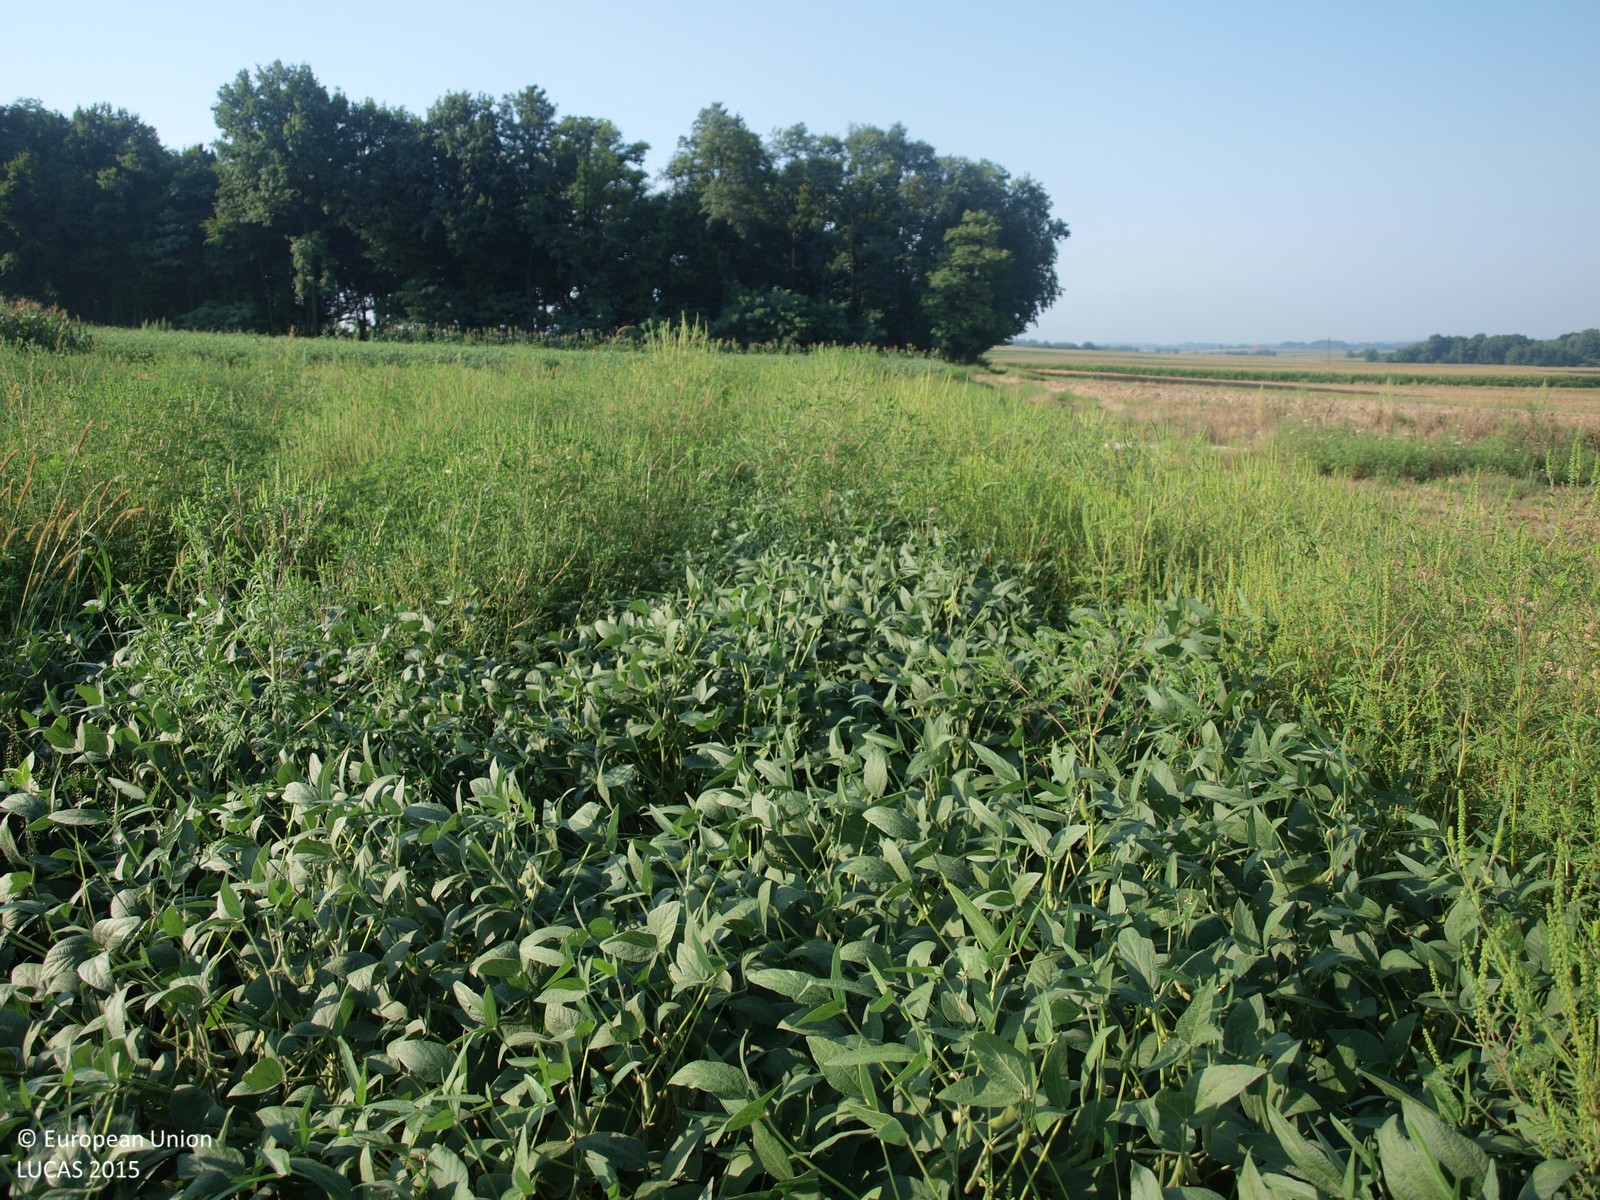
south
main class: Cropland
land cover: Soya
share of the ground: > 75 %
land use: Agriculture (excluding fallow land and kitchen gardens)
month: August
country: HR
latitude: 45.9553
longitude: 16.4893
